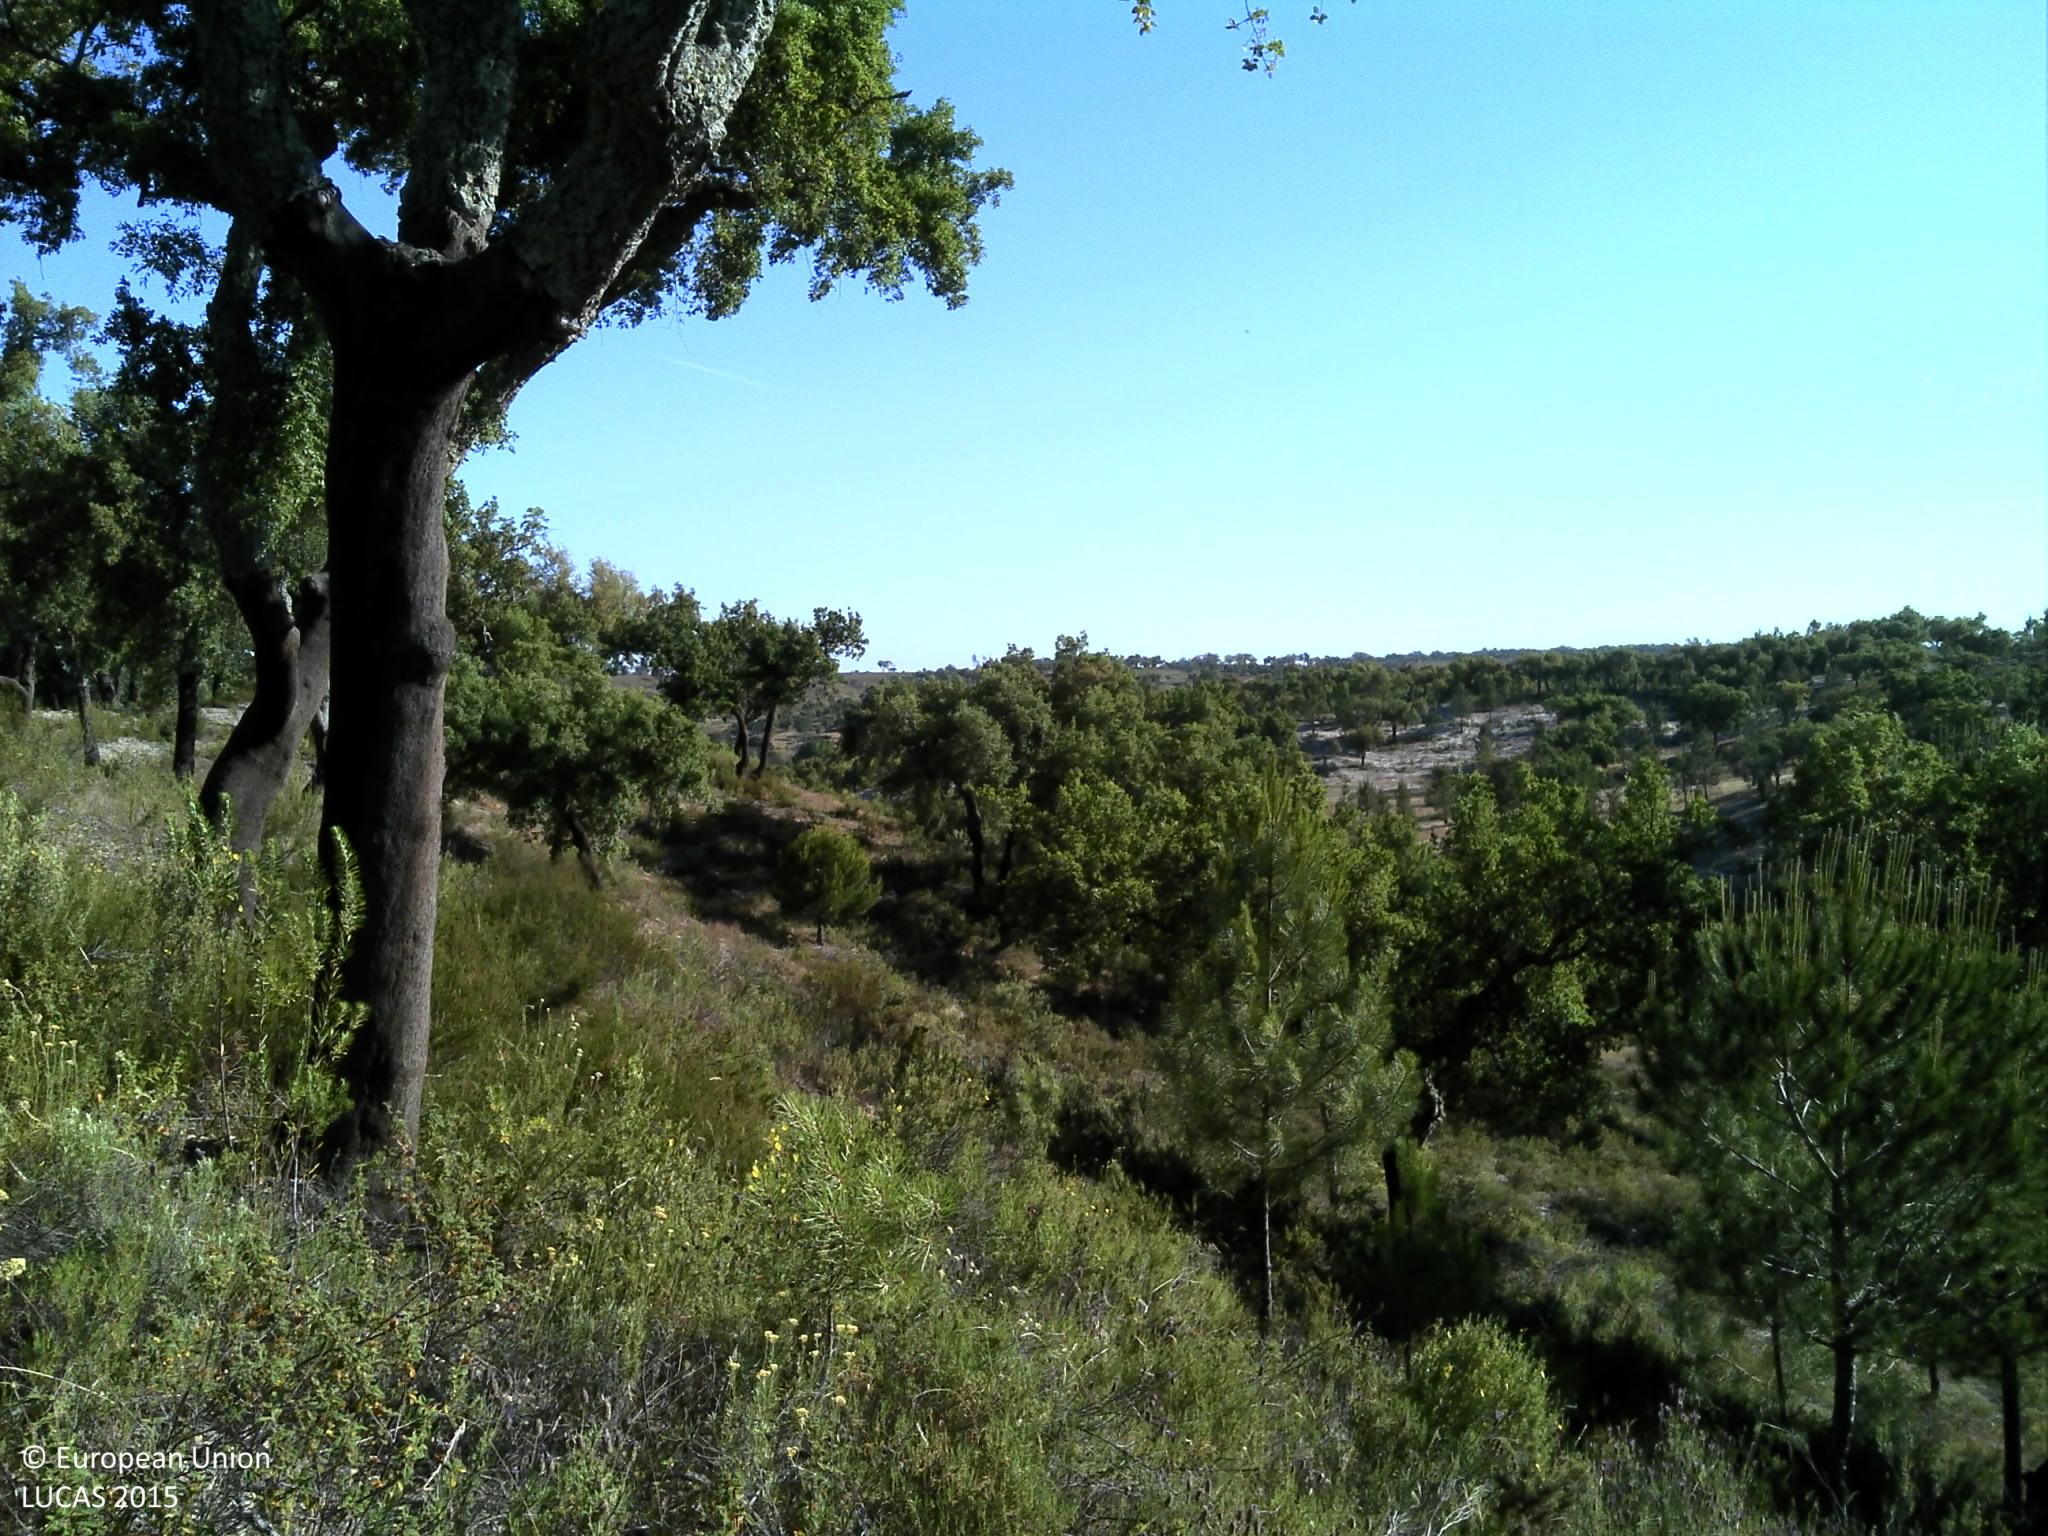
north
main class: Woodland
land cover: Broadleaved woodland
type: broadleaved evergreen forest
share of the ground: 25 - 50 %
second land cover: Shrubland without tree cover
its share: 50 - 75 %
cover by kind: broadleaved forest trees 50 %, shrubs 20 %, unconsolidated bare surface 20 %, herbaceous plants 10 %
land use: Forestry
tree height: > 5 m
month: May
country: PT
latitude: 39.1771
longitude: -8.0072
